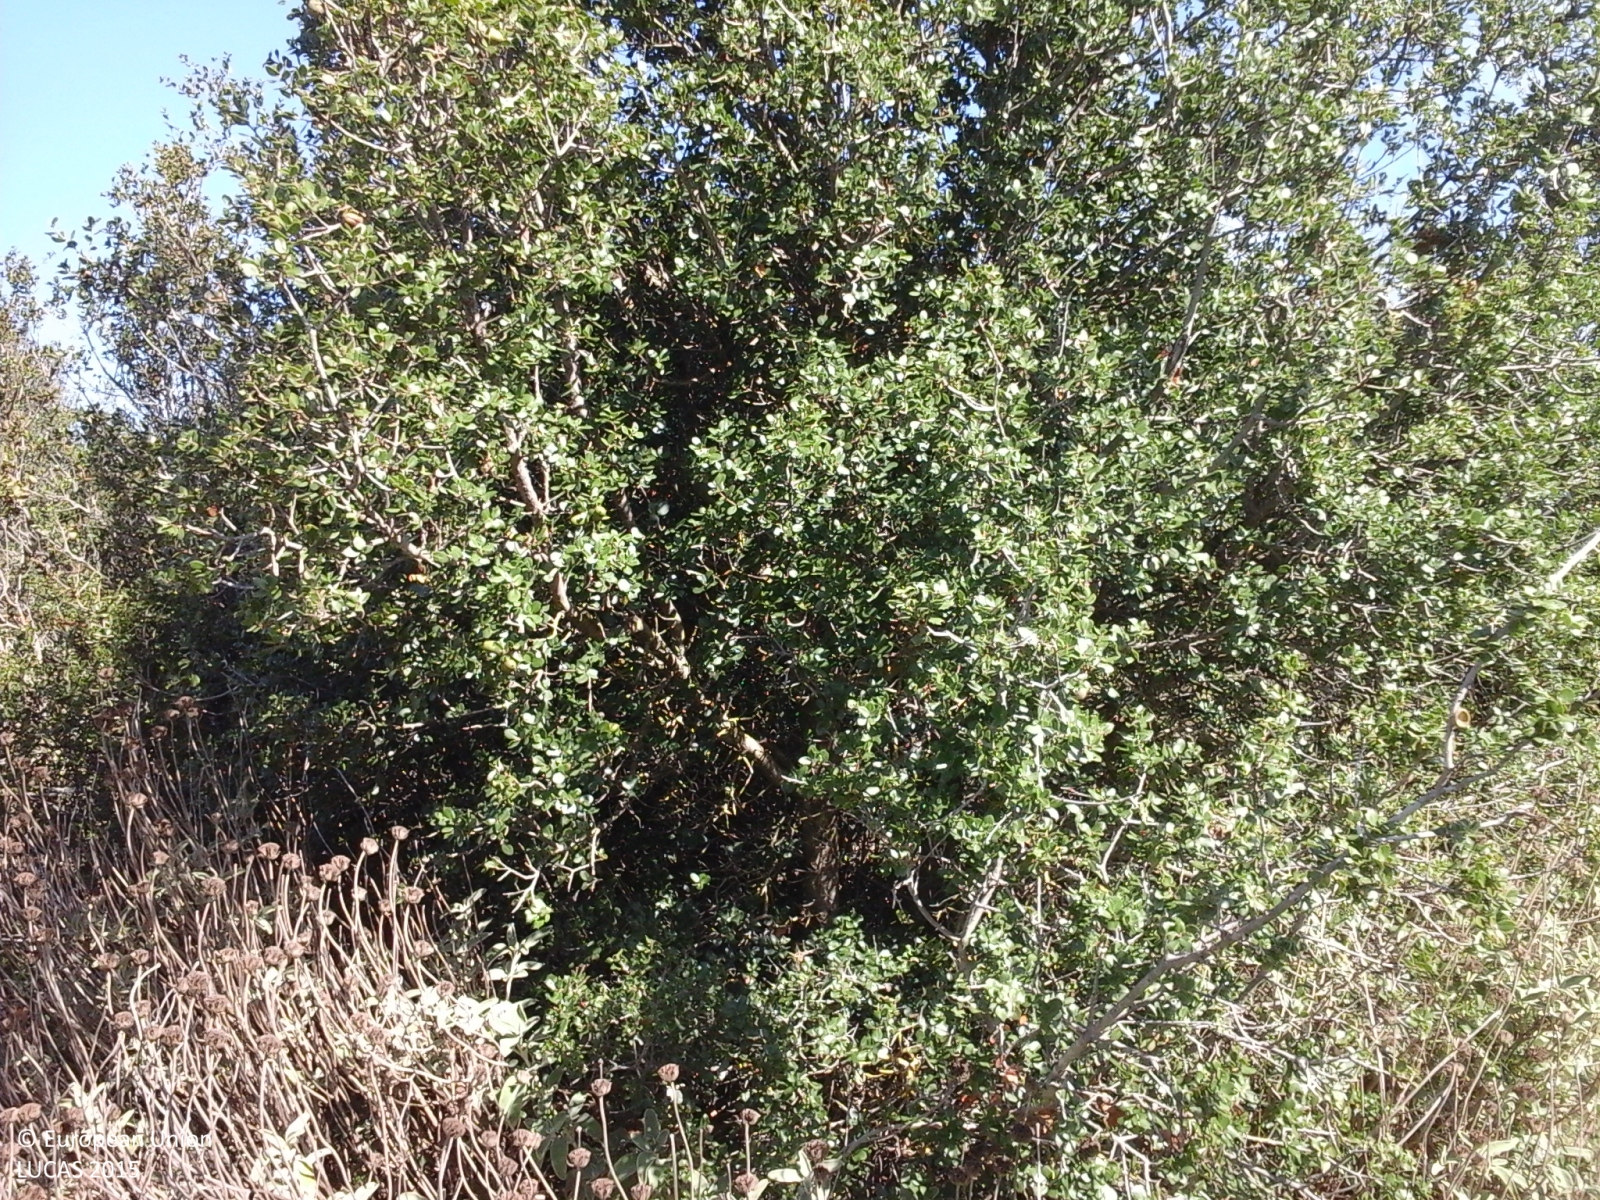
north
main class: Shrubland
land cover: Shrubland without tree cover
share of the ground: 50 - 75 %
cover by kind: shrubs 60 %, herbaceous plants 30 %, unconsolidated bare surface 10 %
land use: Agriculture (excluding fallow land and kitchen gardens)
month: October
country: GR
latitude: 39.5097
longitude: 20.9216
